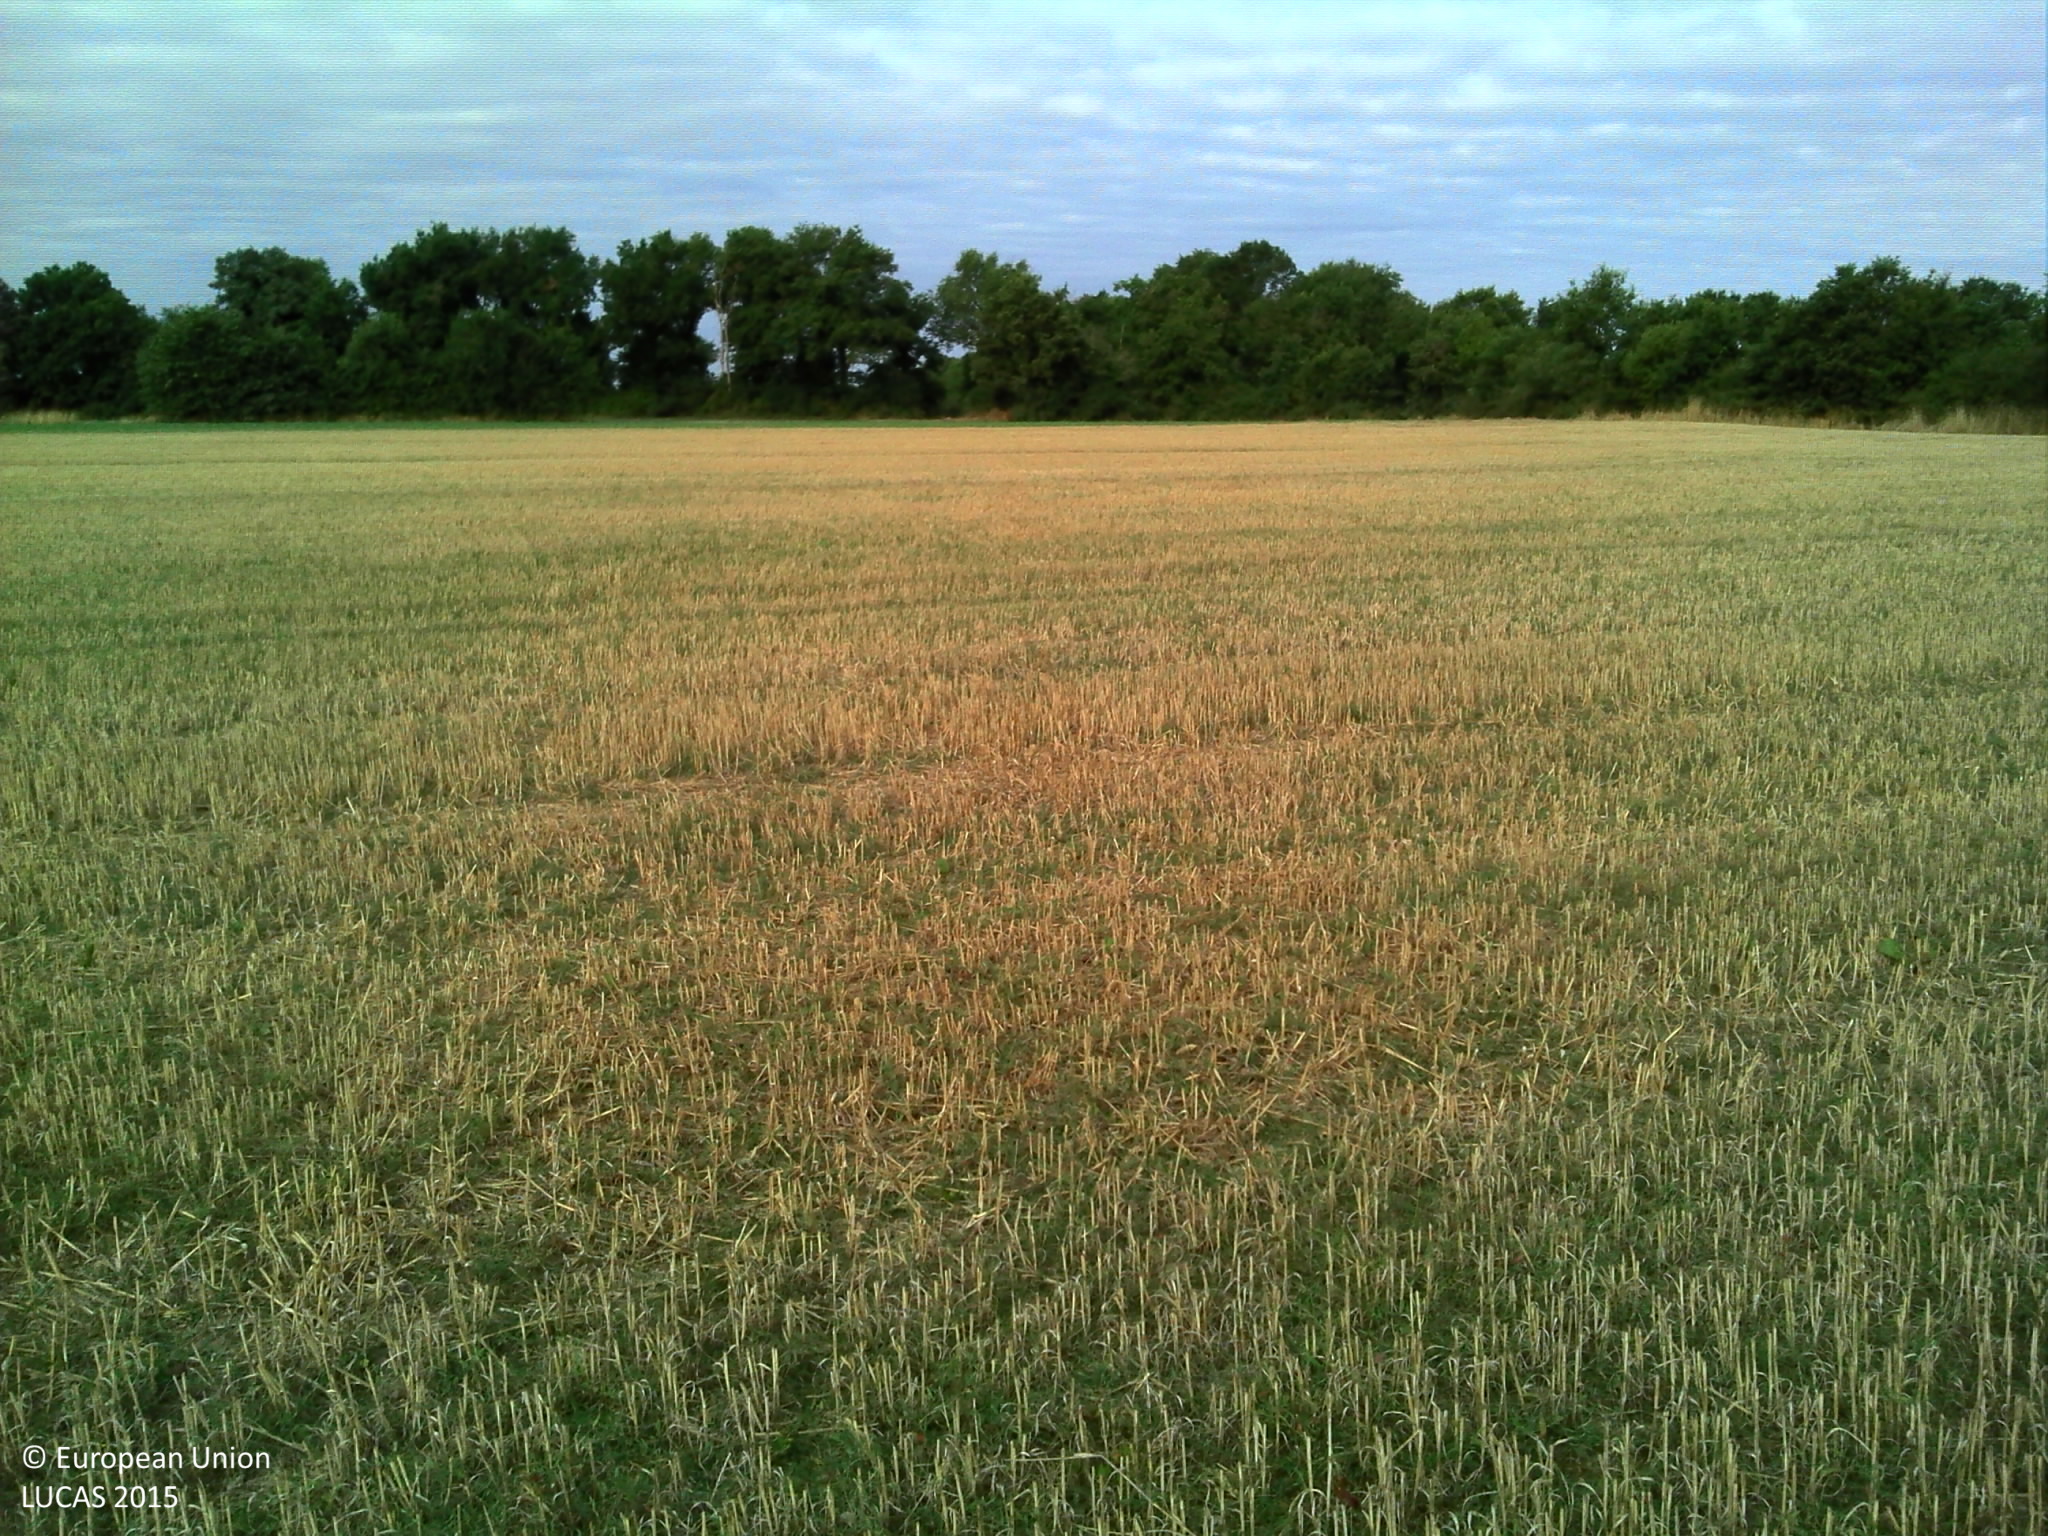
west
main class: Cropland
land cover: Common wheat
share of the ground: > 75 %
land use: Agriculture (excluding fallow land and kitchen gardens)
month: August
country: FR
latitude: 47.0225
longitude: -1.4733
